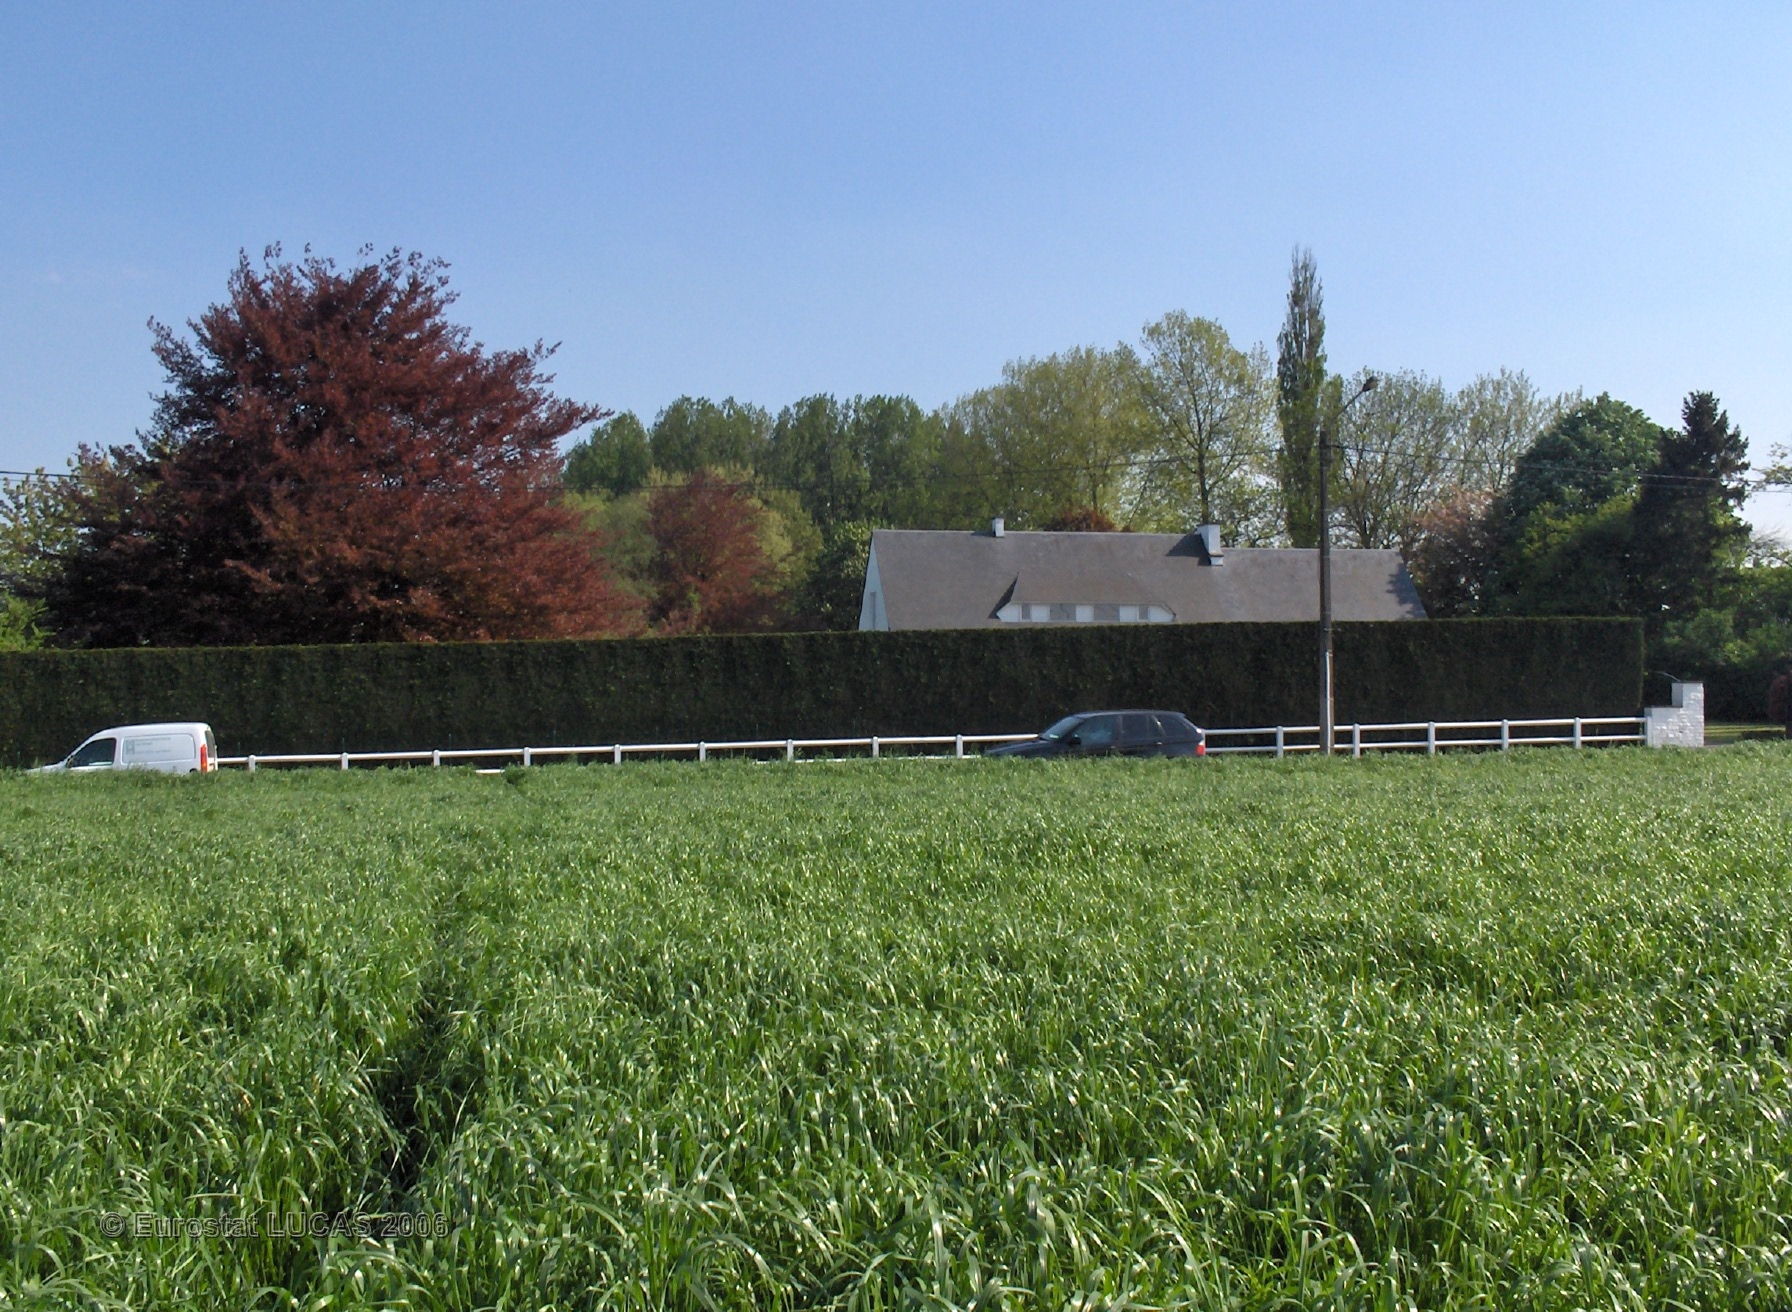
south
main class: Grassland
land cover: Grassland without tree/shrub cover
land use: Agriculture (excluding fallow land and kitchen gardens)
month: May
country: BE
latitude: 50.4655
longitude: 4.4874
